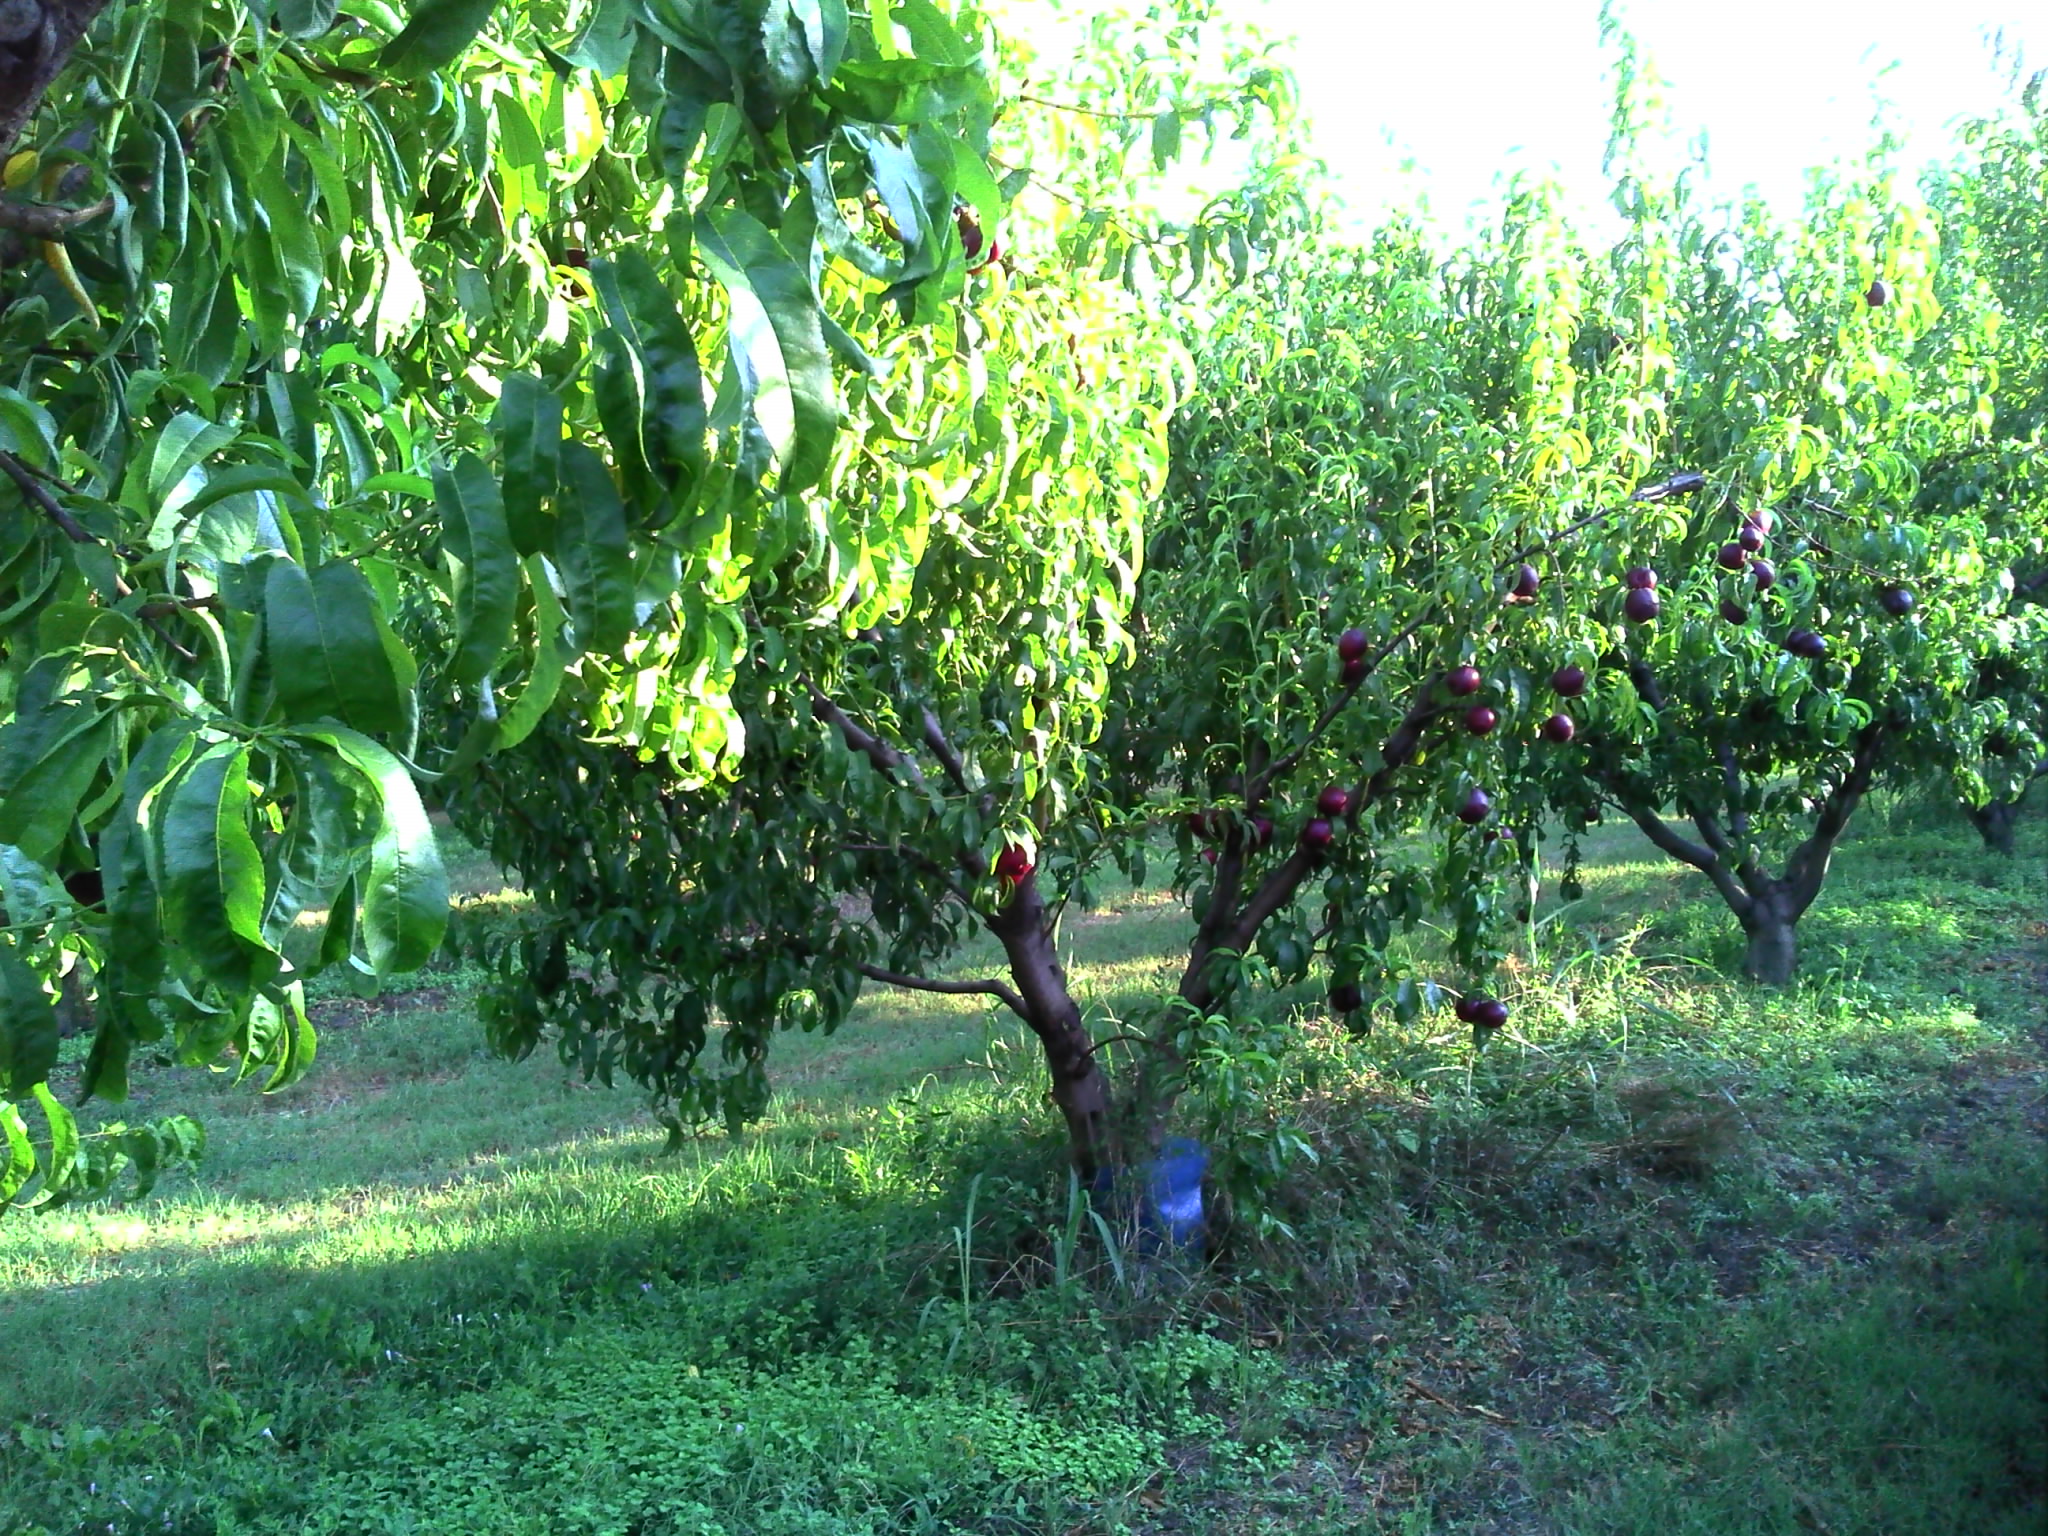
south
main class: Cropland
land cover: Other fruit trees and berries
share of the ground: 50 - 75 %
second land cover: Grassland without tree/shrub cover
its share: 25 - 50 %
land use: Agriculture (excluding fallow land and kitchen gardens)
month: August
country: FR
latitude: 44.2839
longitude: 4.6317
